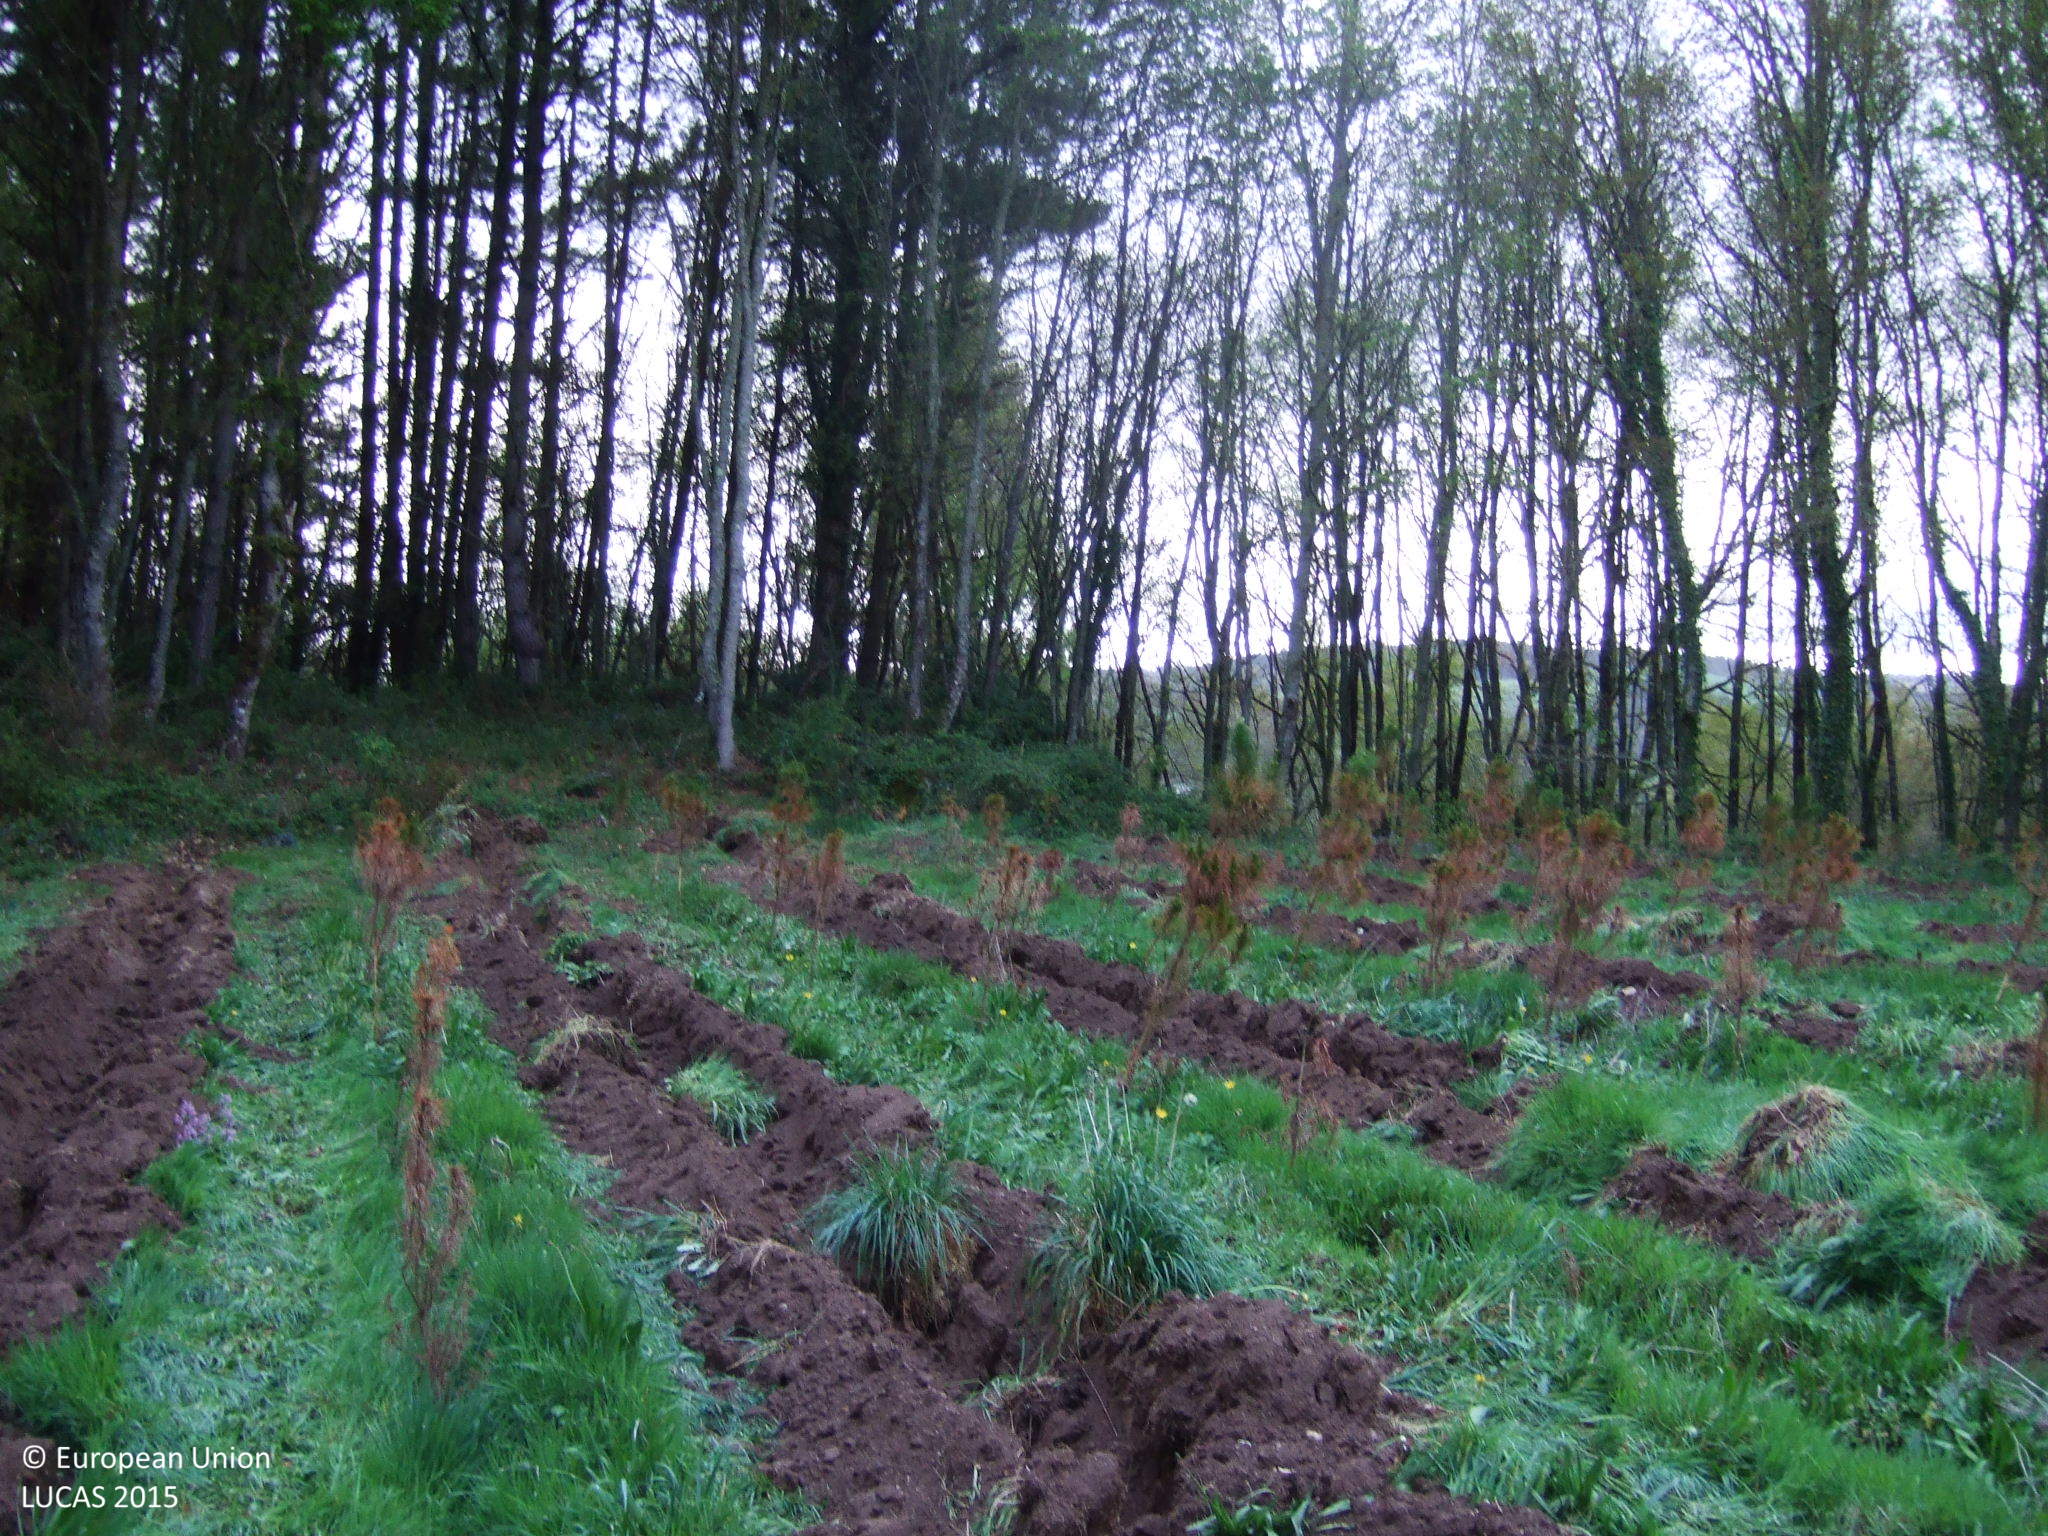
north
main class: Grassland
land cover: Grassland with sparse tree/shrub cover
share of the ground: > 75 %
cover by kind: herbaceous plants 80 %, unconsolidated bare surface 15 %, coniferous forest trees 5 %
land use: Forestry
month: April
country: ES
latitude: 42.9722
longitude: -7.3218
